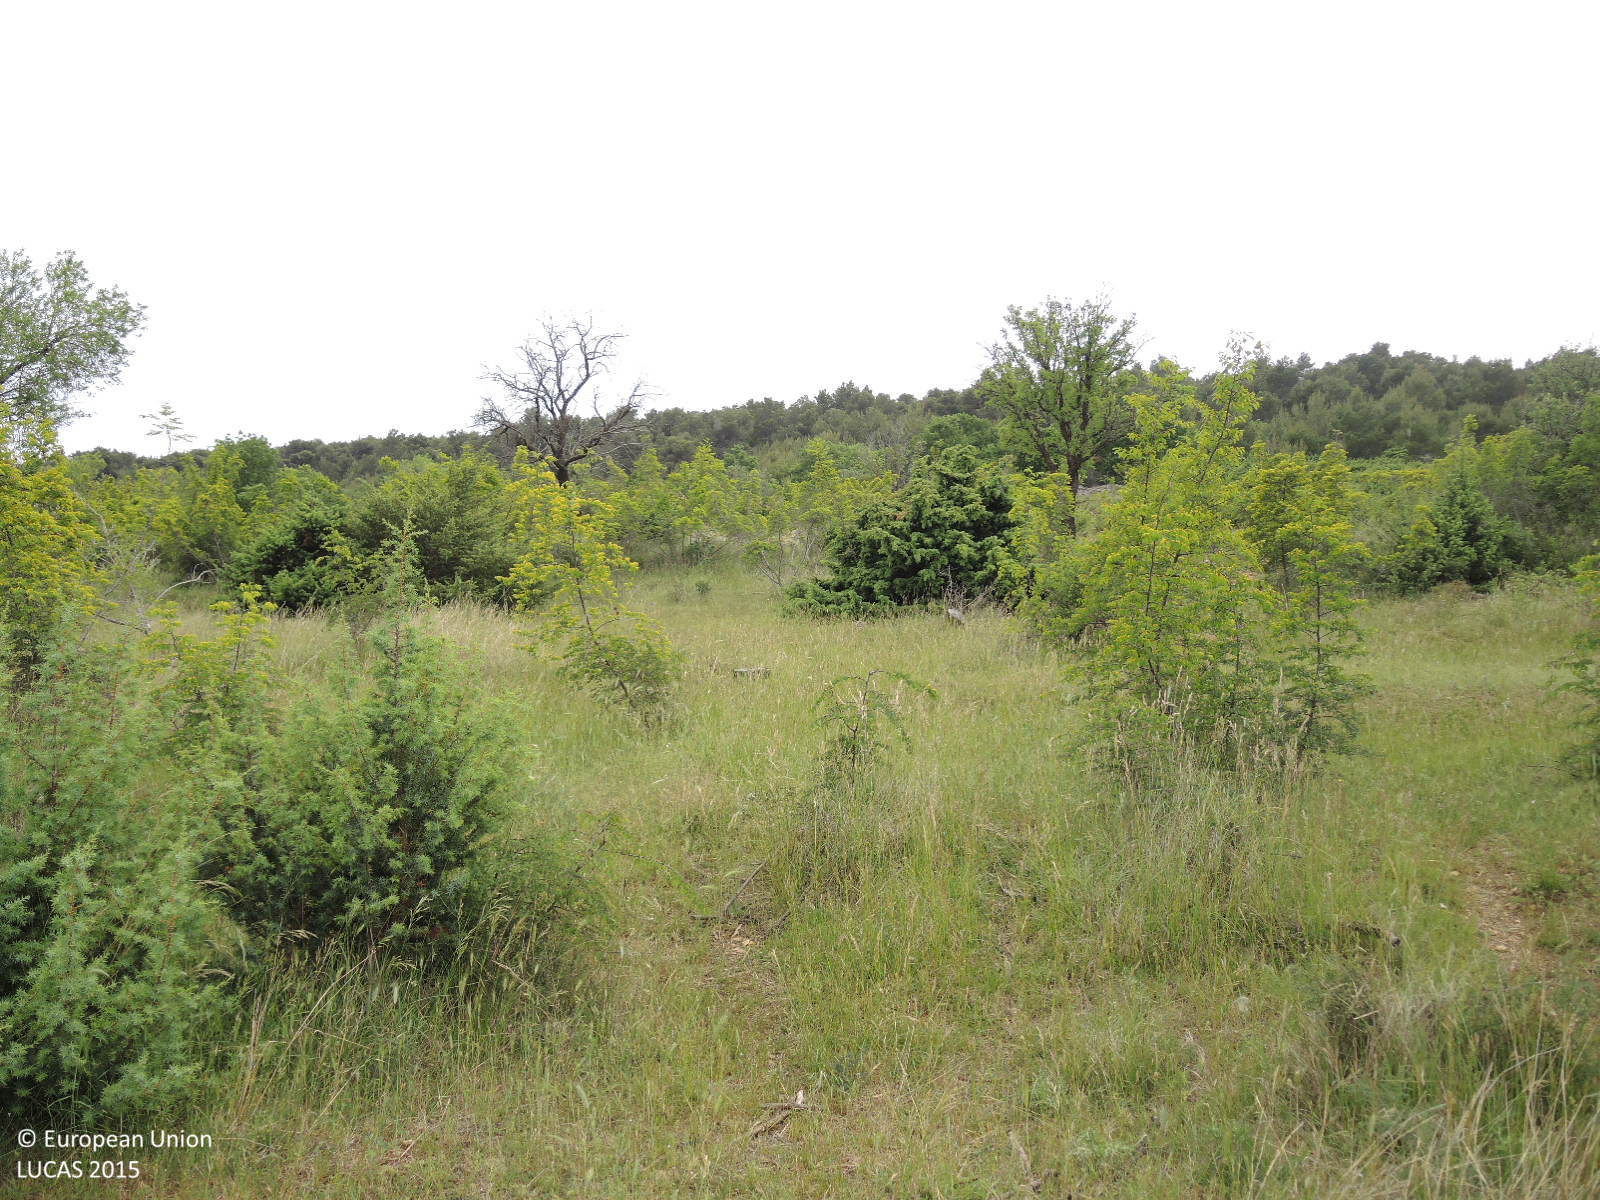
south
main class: Shrubland
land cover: Shrubland without tree cover
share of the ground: 10 - 25 %
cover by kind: herbaceous plants 65 %, shrubs 25 %, unconsolidated bare surface 10 %
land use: Semi-natural and natural areas not in use
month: May
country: HR
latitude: 43.9153
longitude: 15.8322
